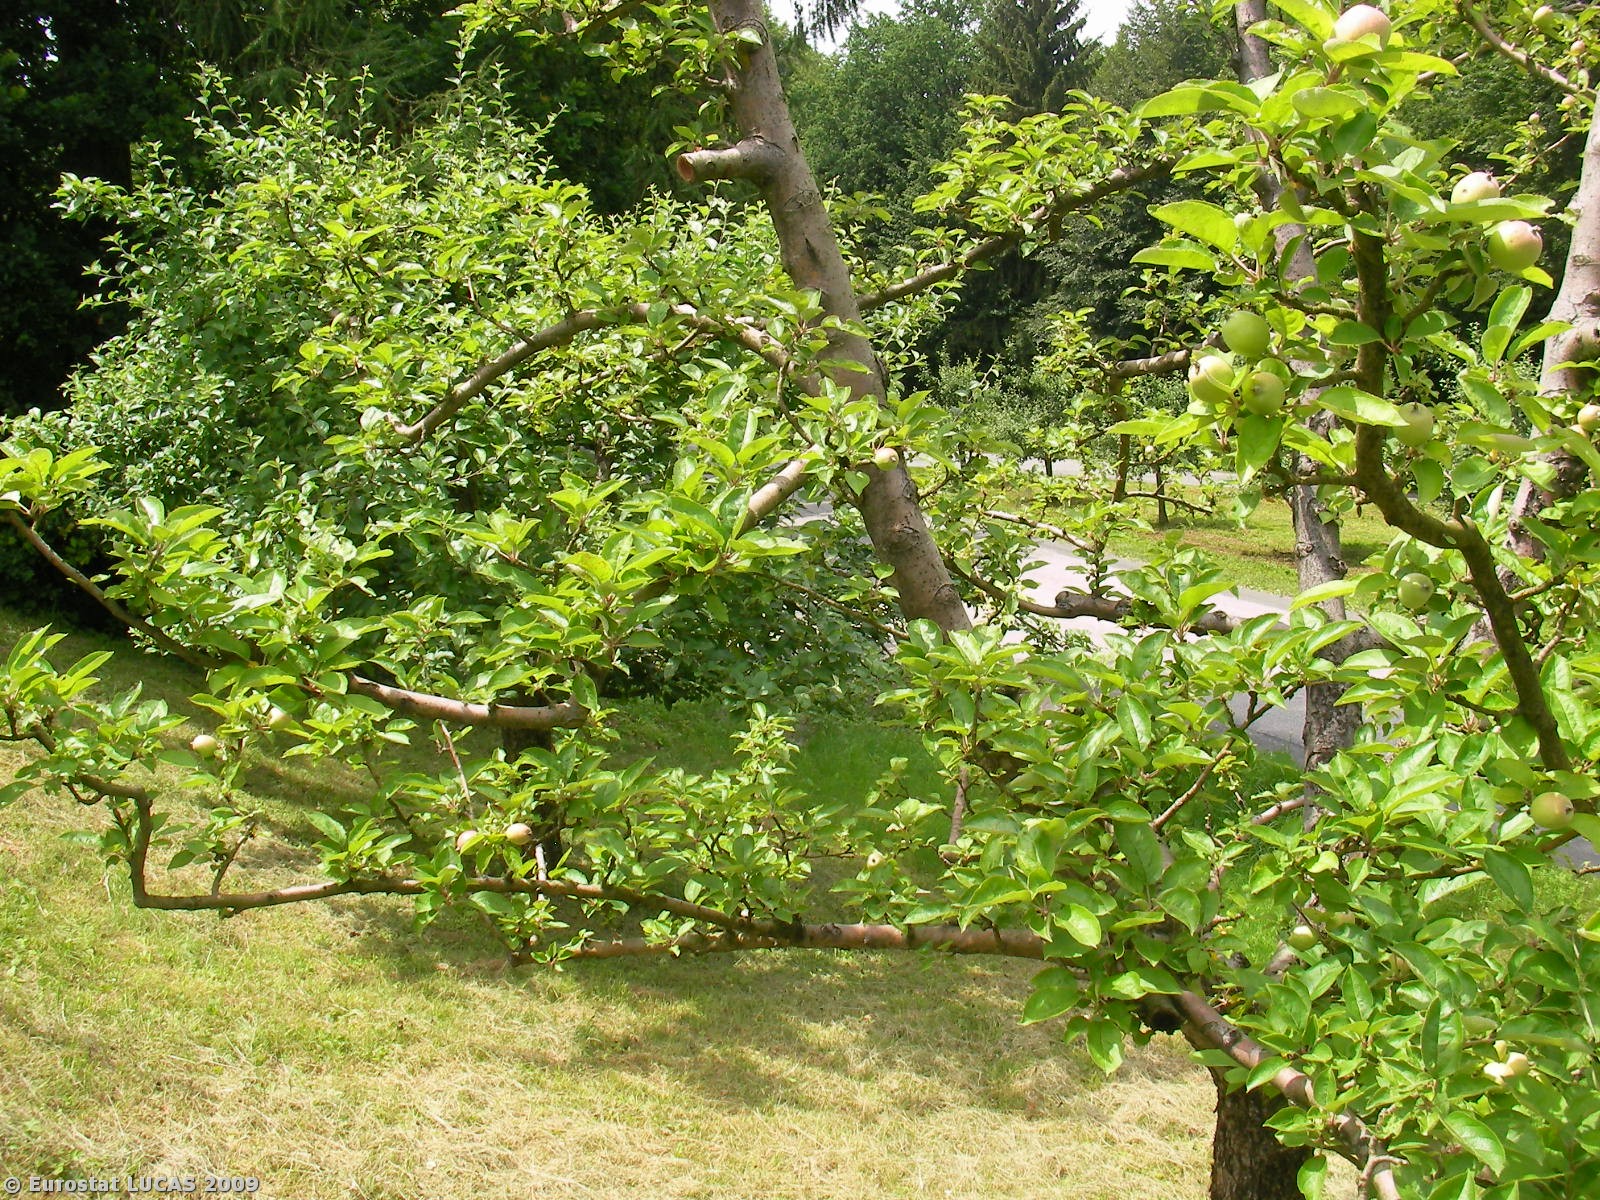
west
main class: Cropland
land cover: Apple fruit
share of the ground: 25 - 50 %
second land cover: Grassland with sparse tree/shrub cover
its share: > 75 %
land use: Agriculture (excluding fallow land and kitchen gardens)
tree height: > 5 m
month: June
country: AT
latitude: 46.9468
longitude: 15.5573
